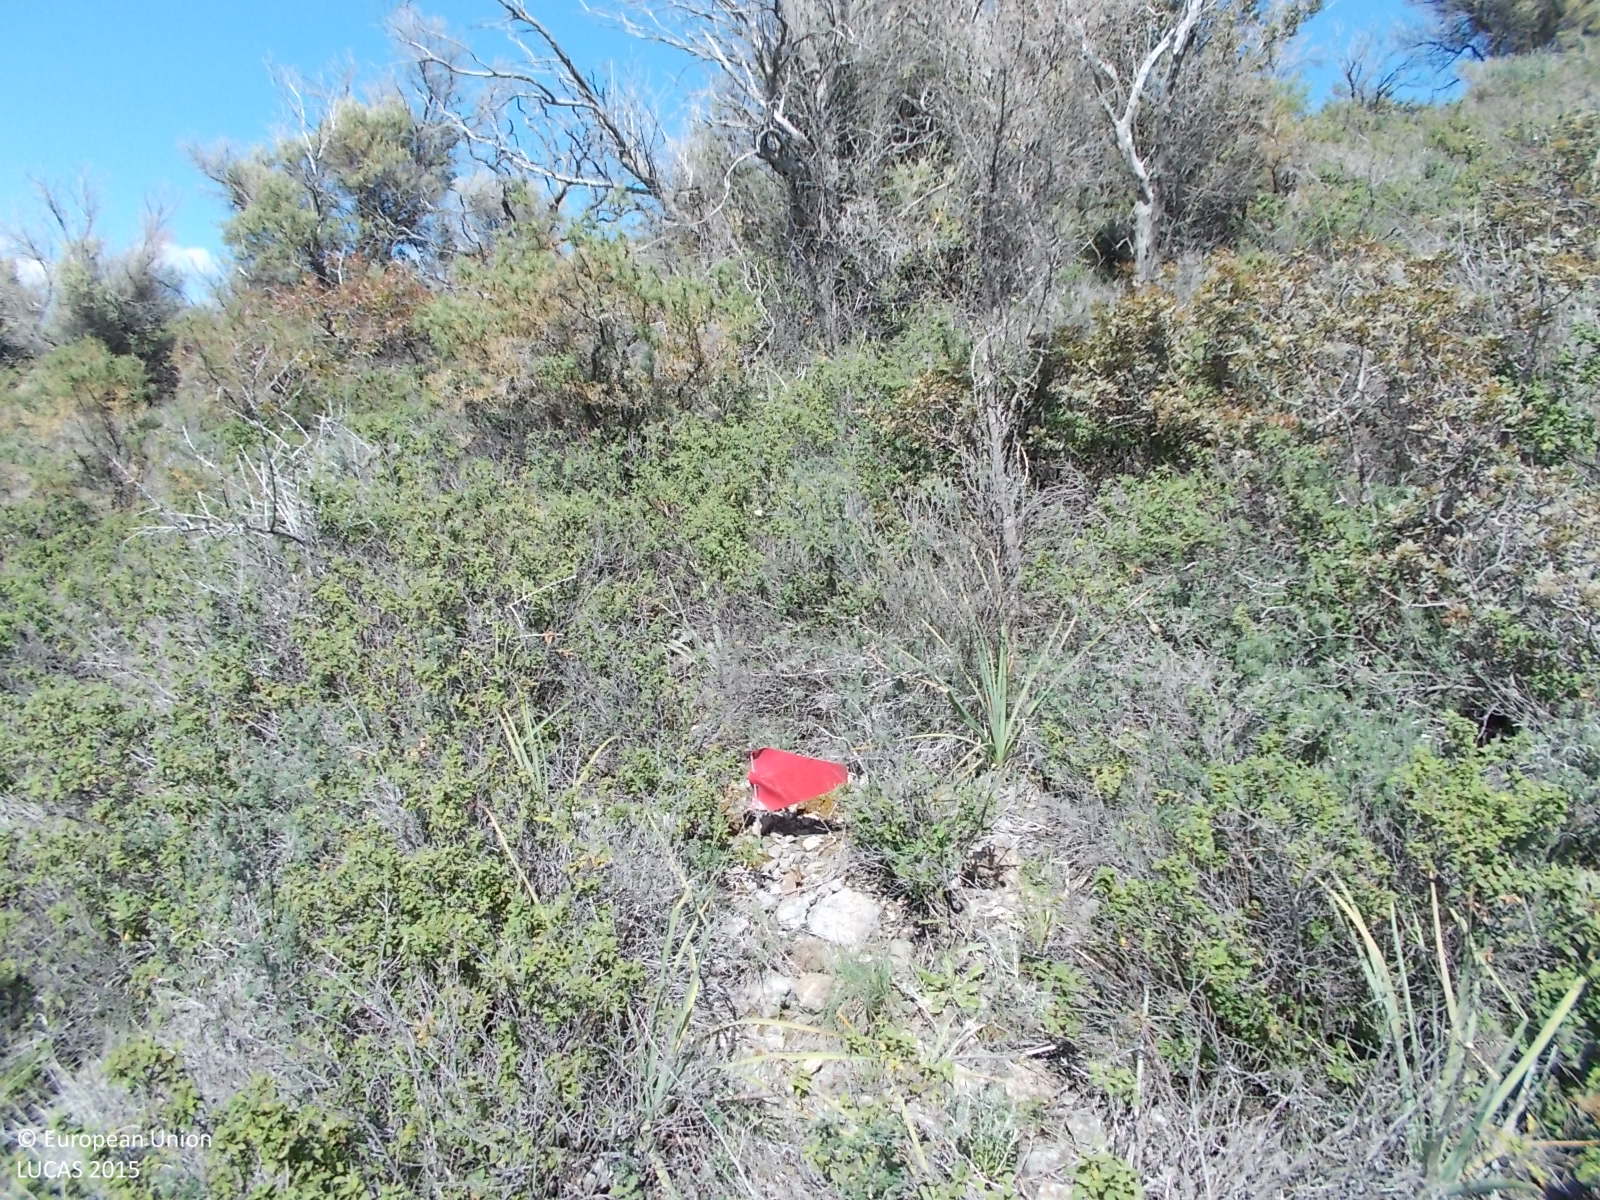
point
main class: Woodland
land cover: Other mixed woodland
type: coniferous forest of the mediterranean region
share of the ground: > 75 %
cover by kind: shrubs 60 %, coniferous forest trees 20 %, broadleaved forest trees 20 %
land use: Semi-natural and natural areas not in use
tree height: < 5 m
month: April
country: CY
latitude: 34.8075
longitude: 33.0938
